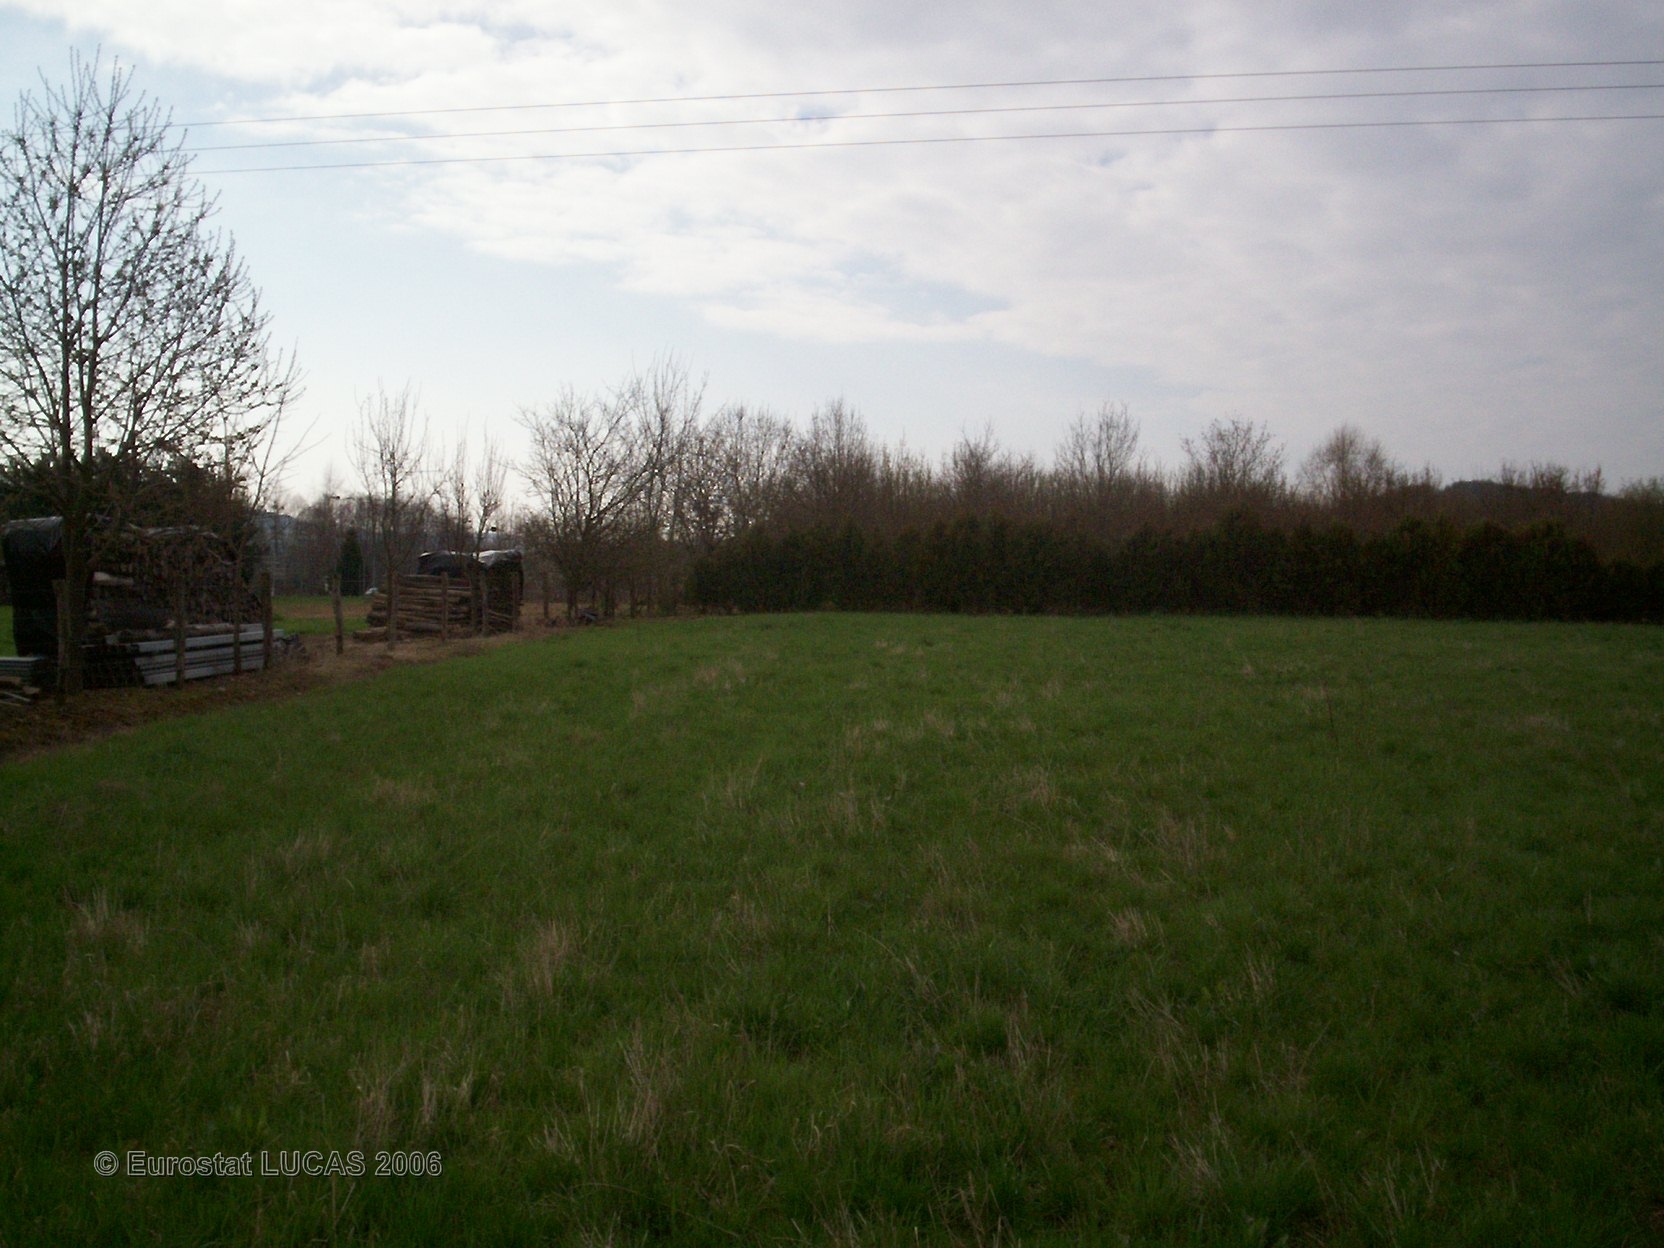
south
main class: Grassland
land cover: Grassland without tree/shrub cover
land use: Agriculture (excluding fallow land and kitchen gardens)
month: April
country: FR
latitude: 47.9599
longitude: 5.2722
